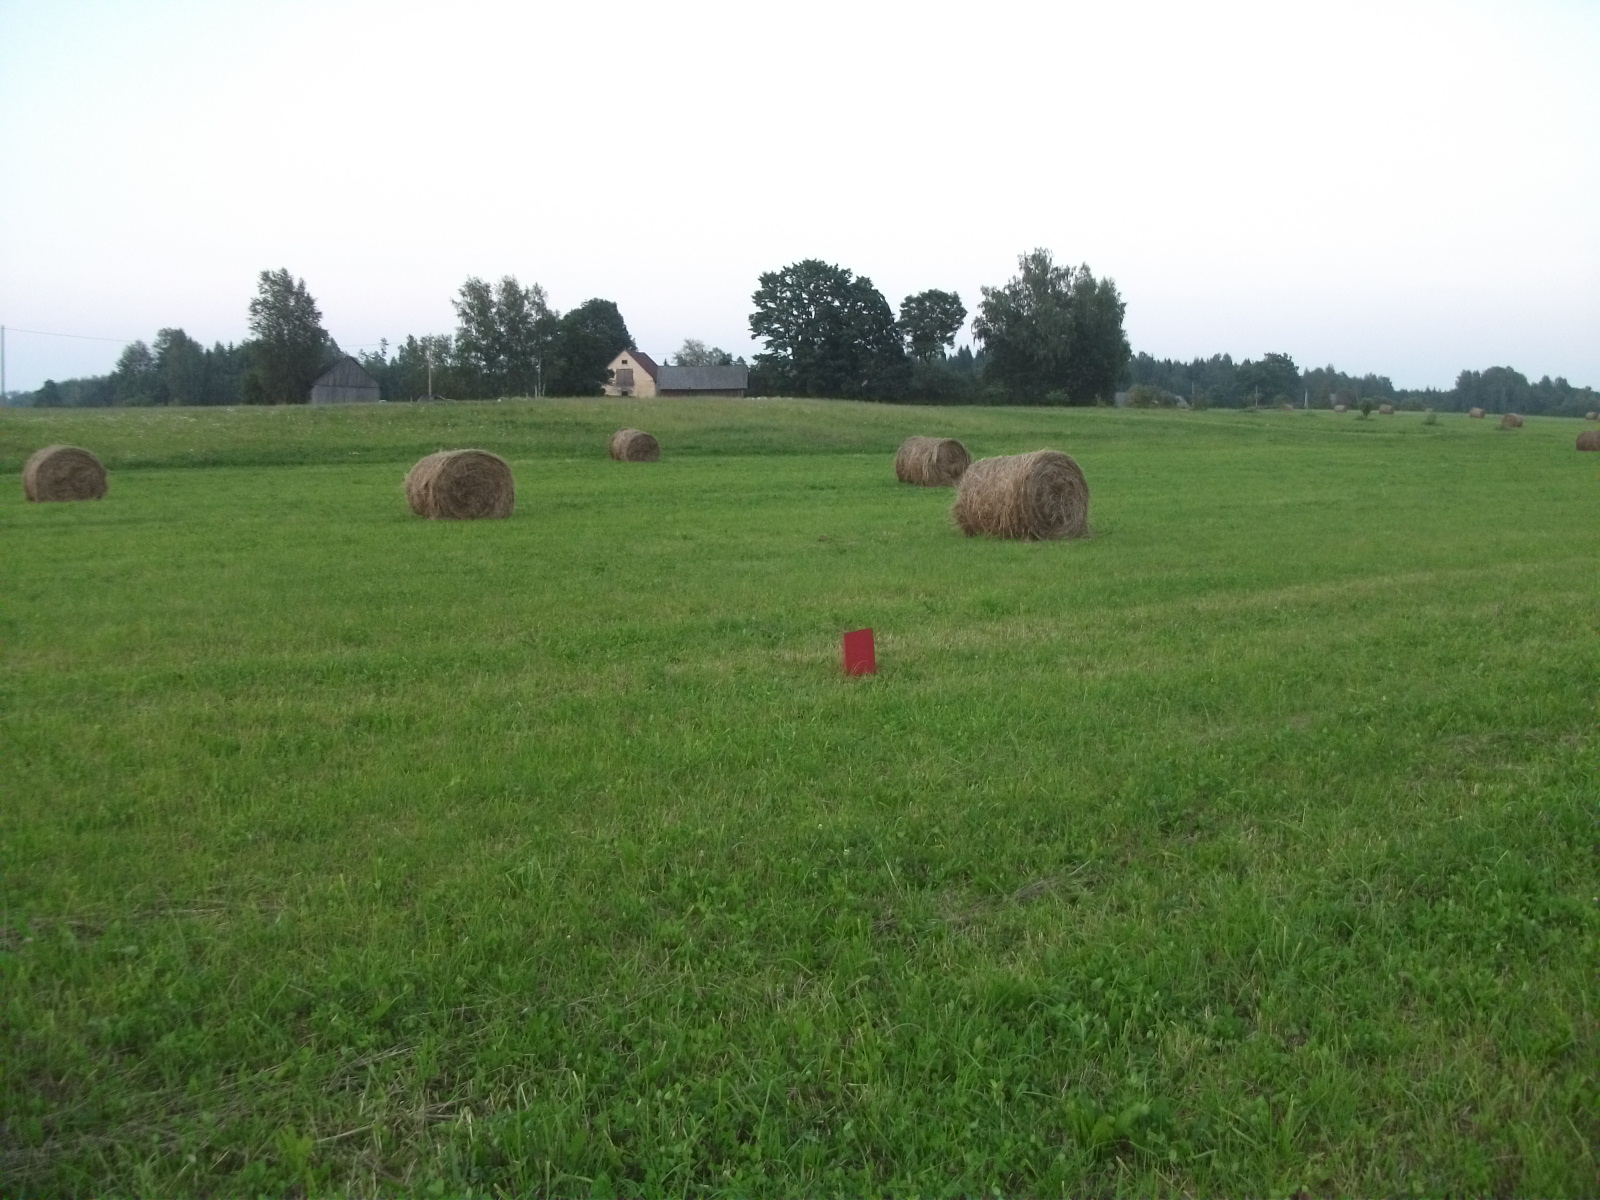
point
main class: Grassland
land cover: Grassland without tree/shrub cover
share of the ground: > 75 %
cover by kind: herbaceous plants 100 %
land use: Agriculture (excluding fallow land and kitchen gardens)
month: August
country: LV
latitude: 56.7382
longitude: 25.5361
